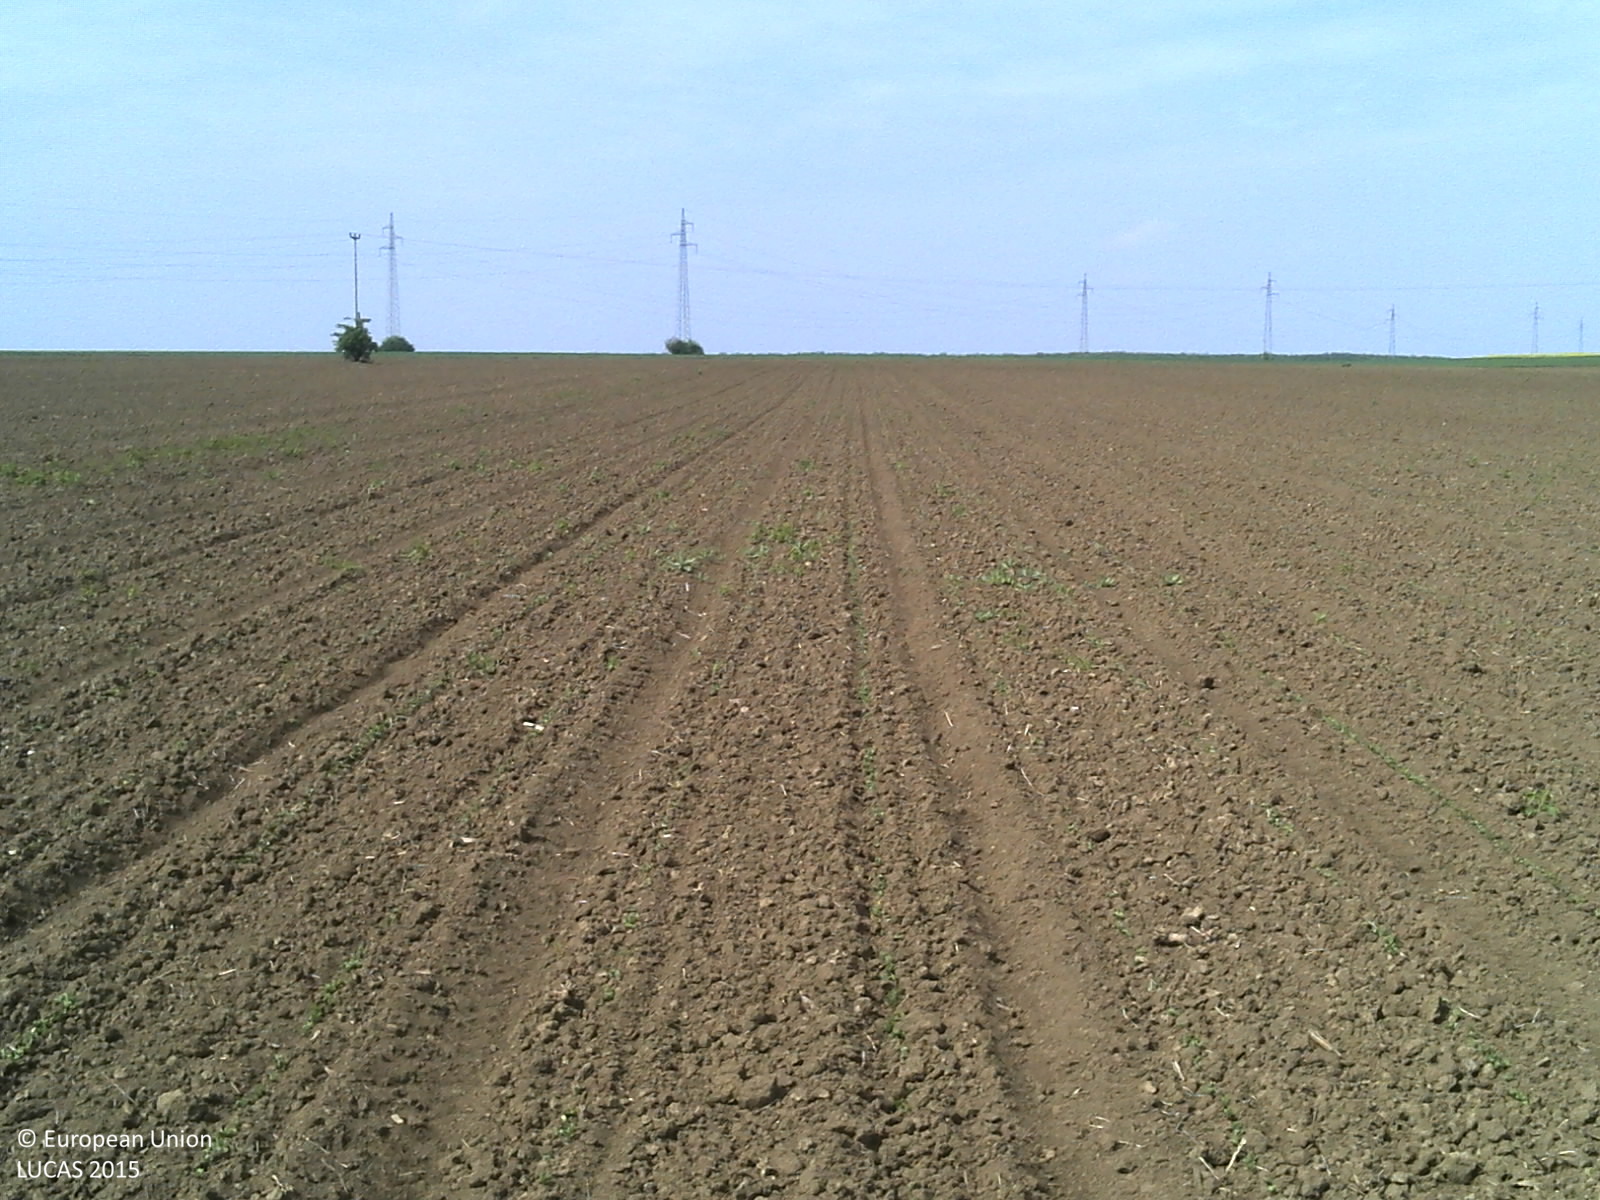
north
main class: Cropland
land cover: Soya
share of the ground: < 10 %
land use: Agriculture (excluding fallow land and kitchen gardens)
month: May
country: HR
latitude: 45.1847
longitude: 19.0827
